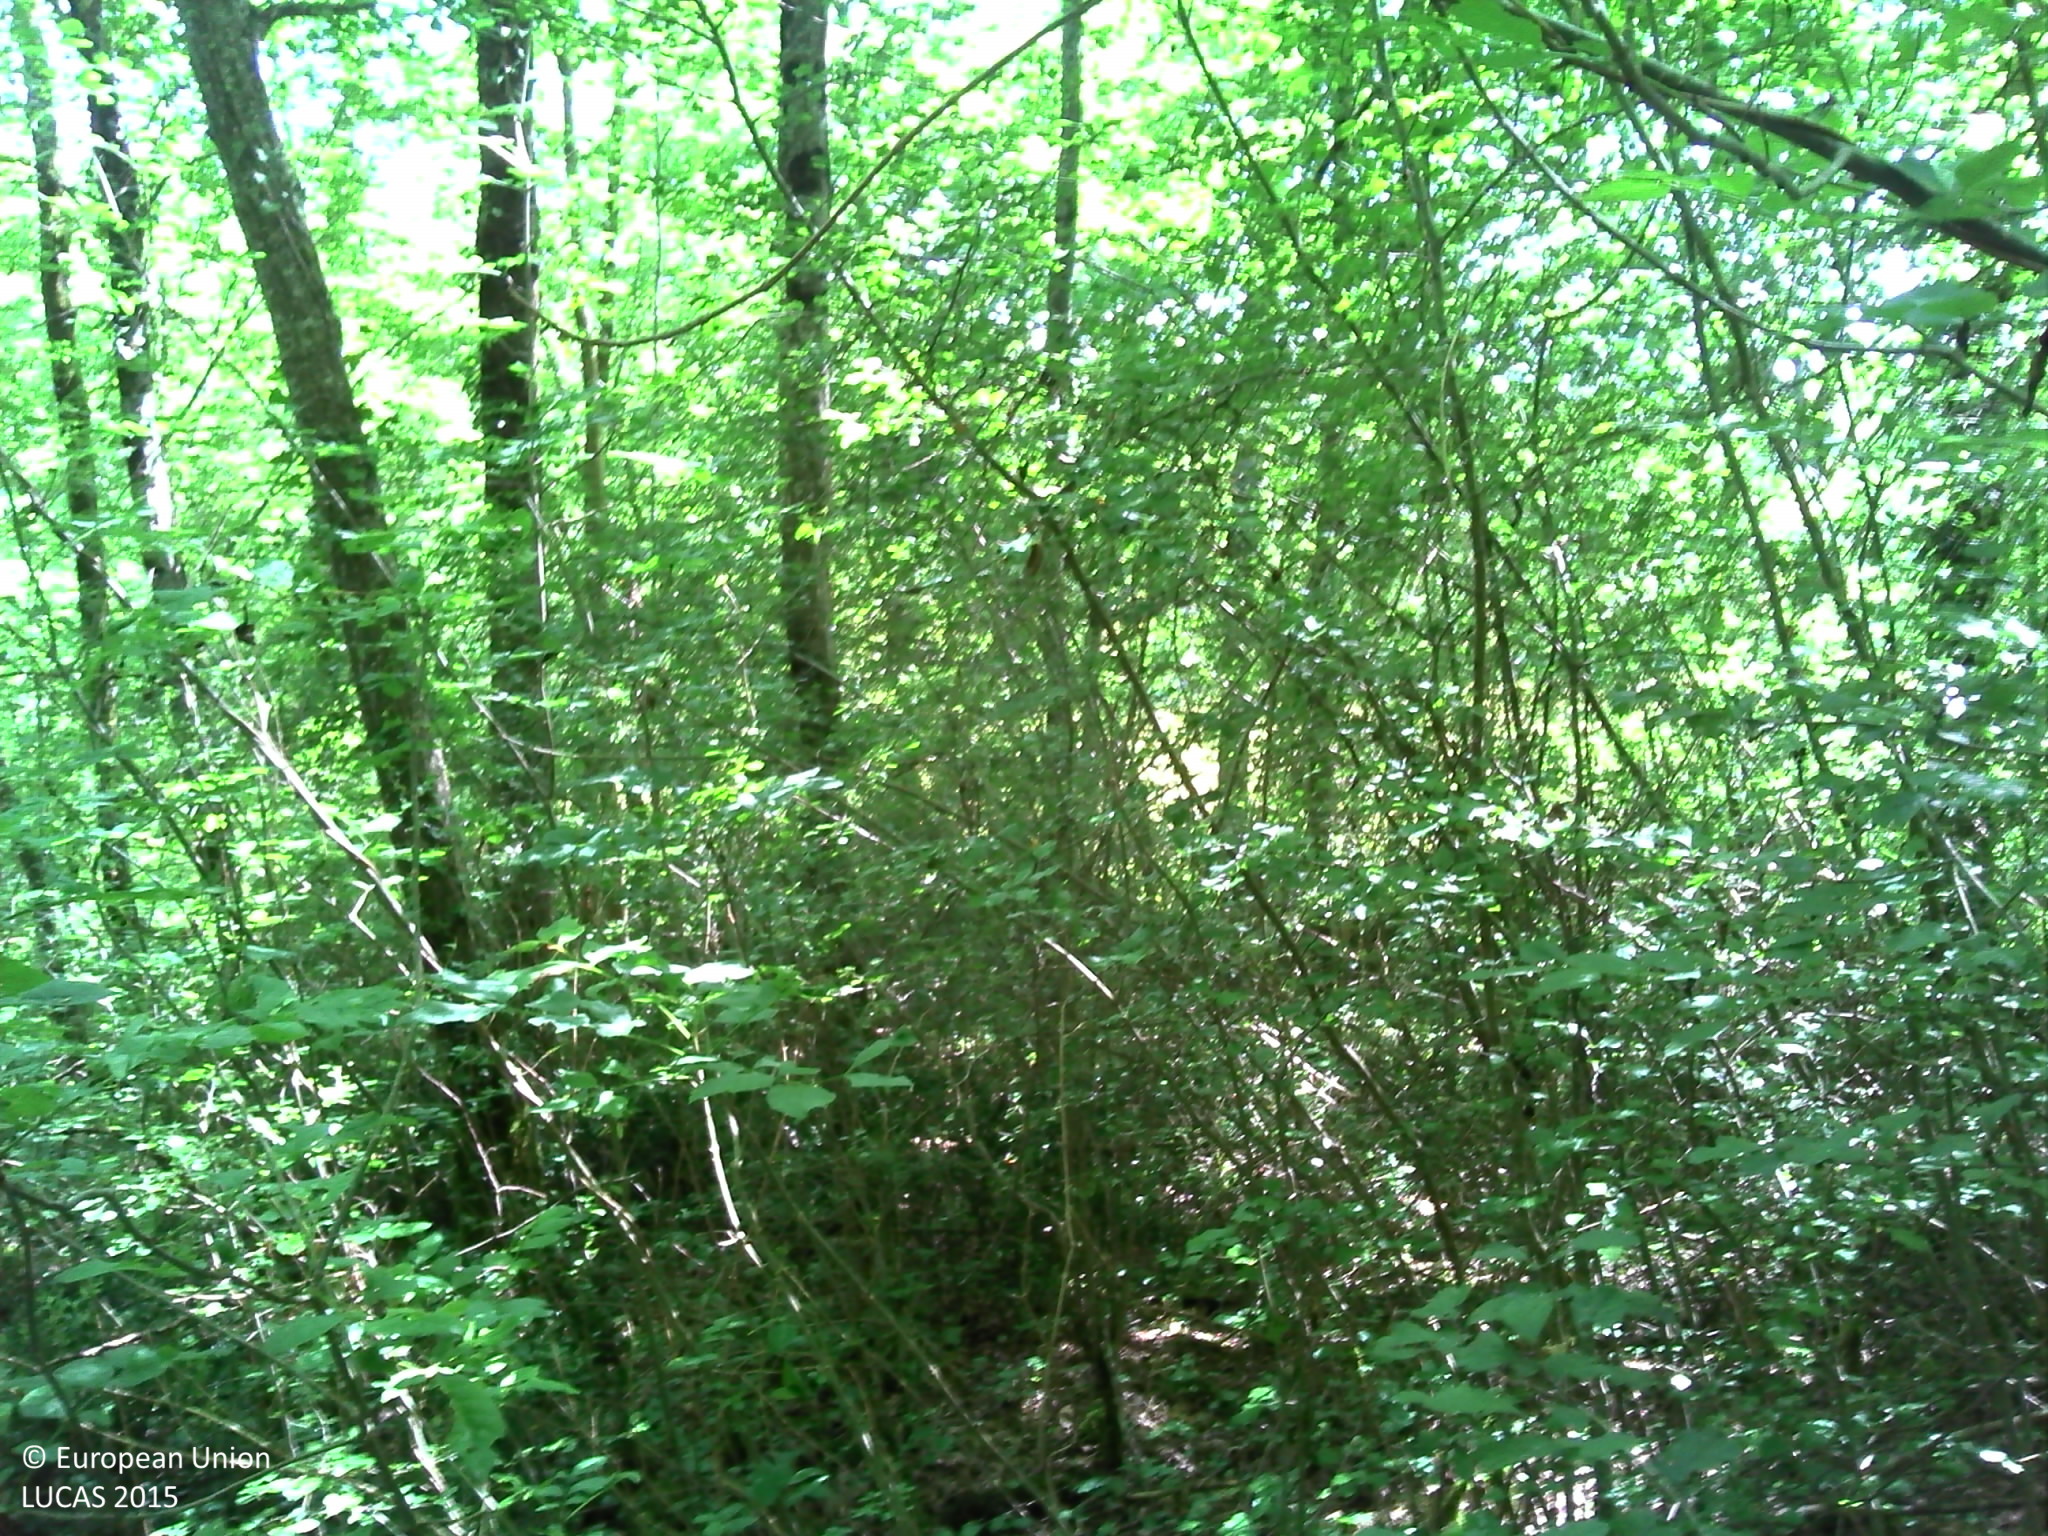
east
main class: Woodland
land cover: Broadleaved woodland
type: mesophytic deciduous forest
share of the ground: > 75 %
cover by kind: broadleaved forest trees 95 %, herbaceous plants 5 %
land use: Semi-natural and natural areas not in use
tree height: > 5 m
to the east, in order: Broadleaved woodland; Fences; Grassland without tree/shrub cover; Fences; Broadleaved woodland; Grassland without tree/shrub cover
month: June
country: FR
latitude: 44.7862
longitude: 1.7956
